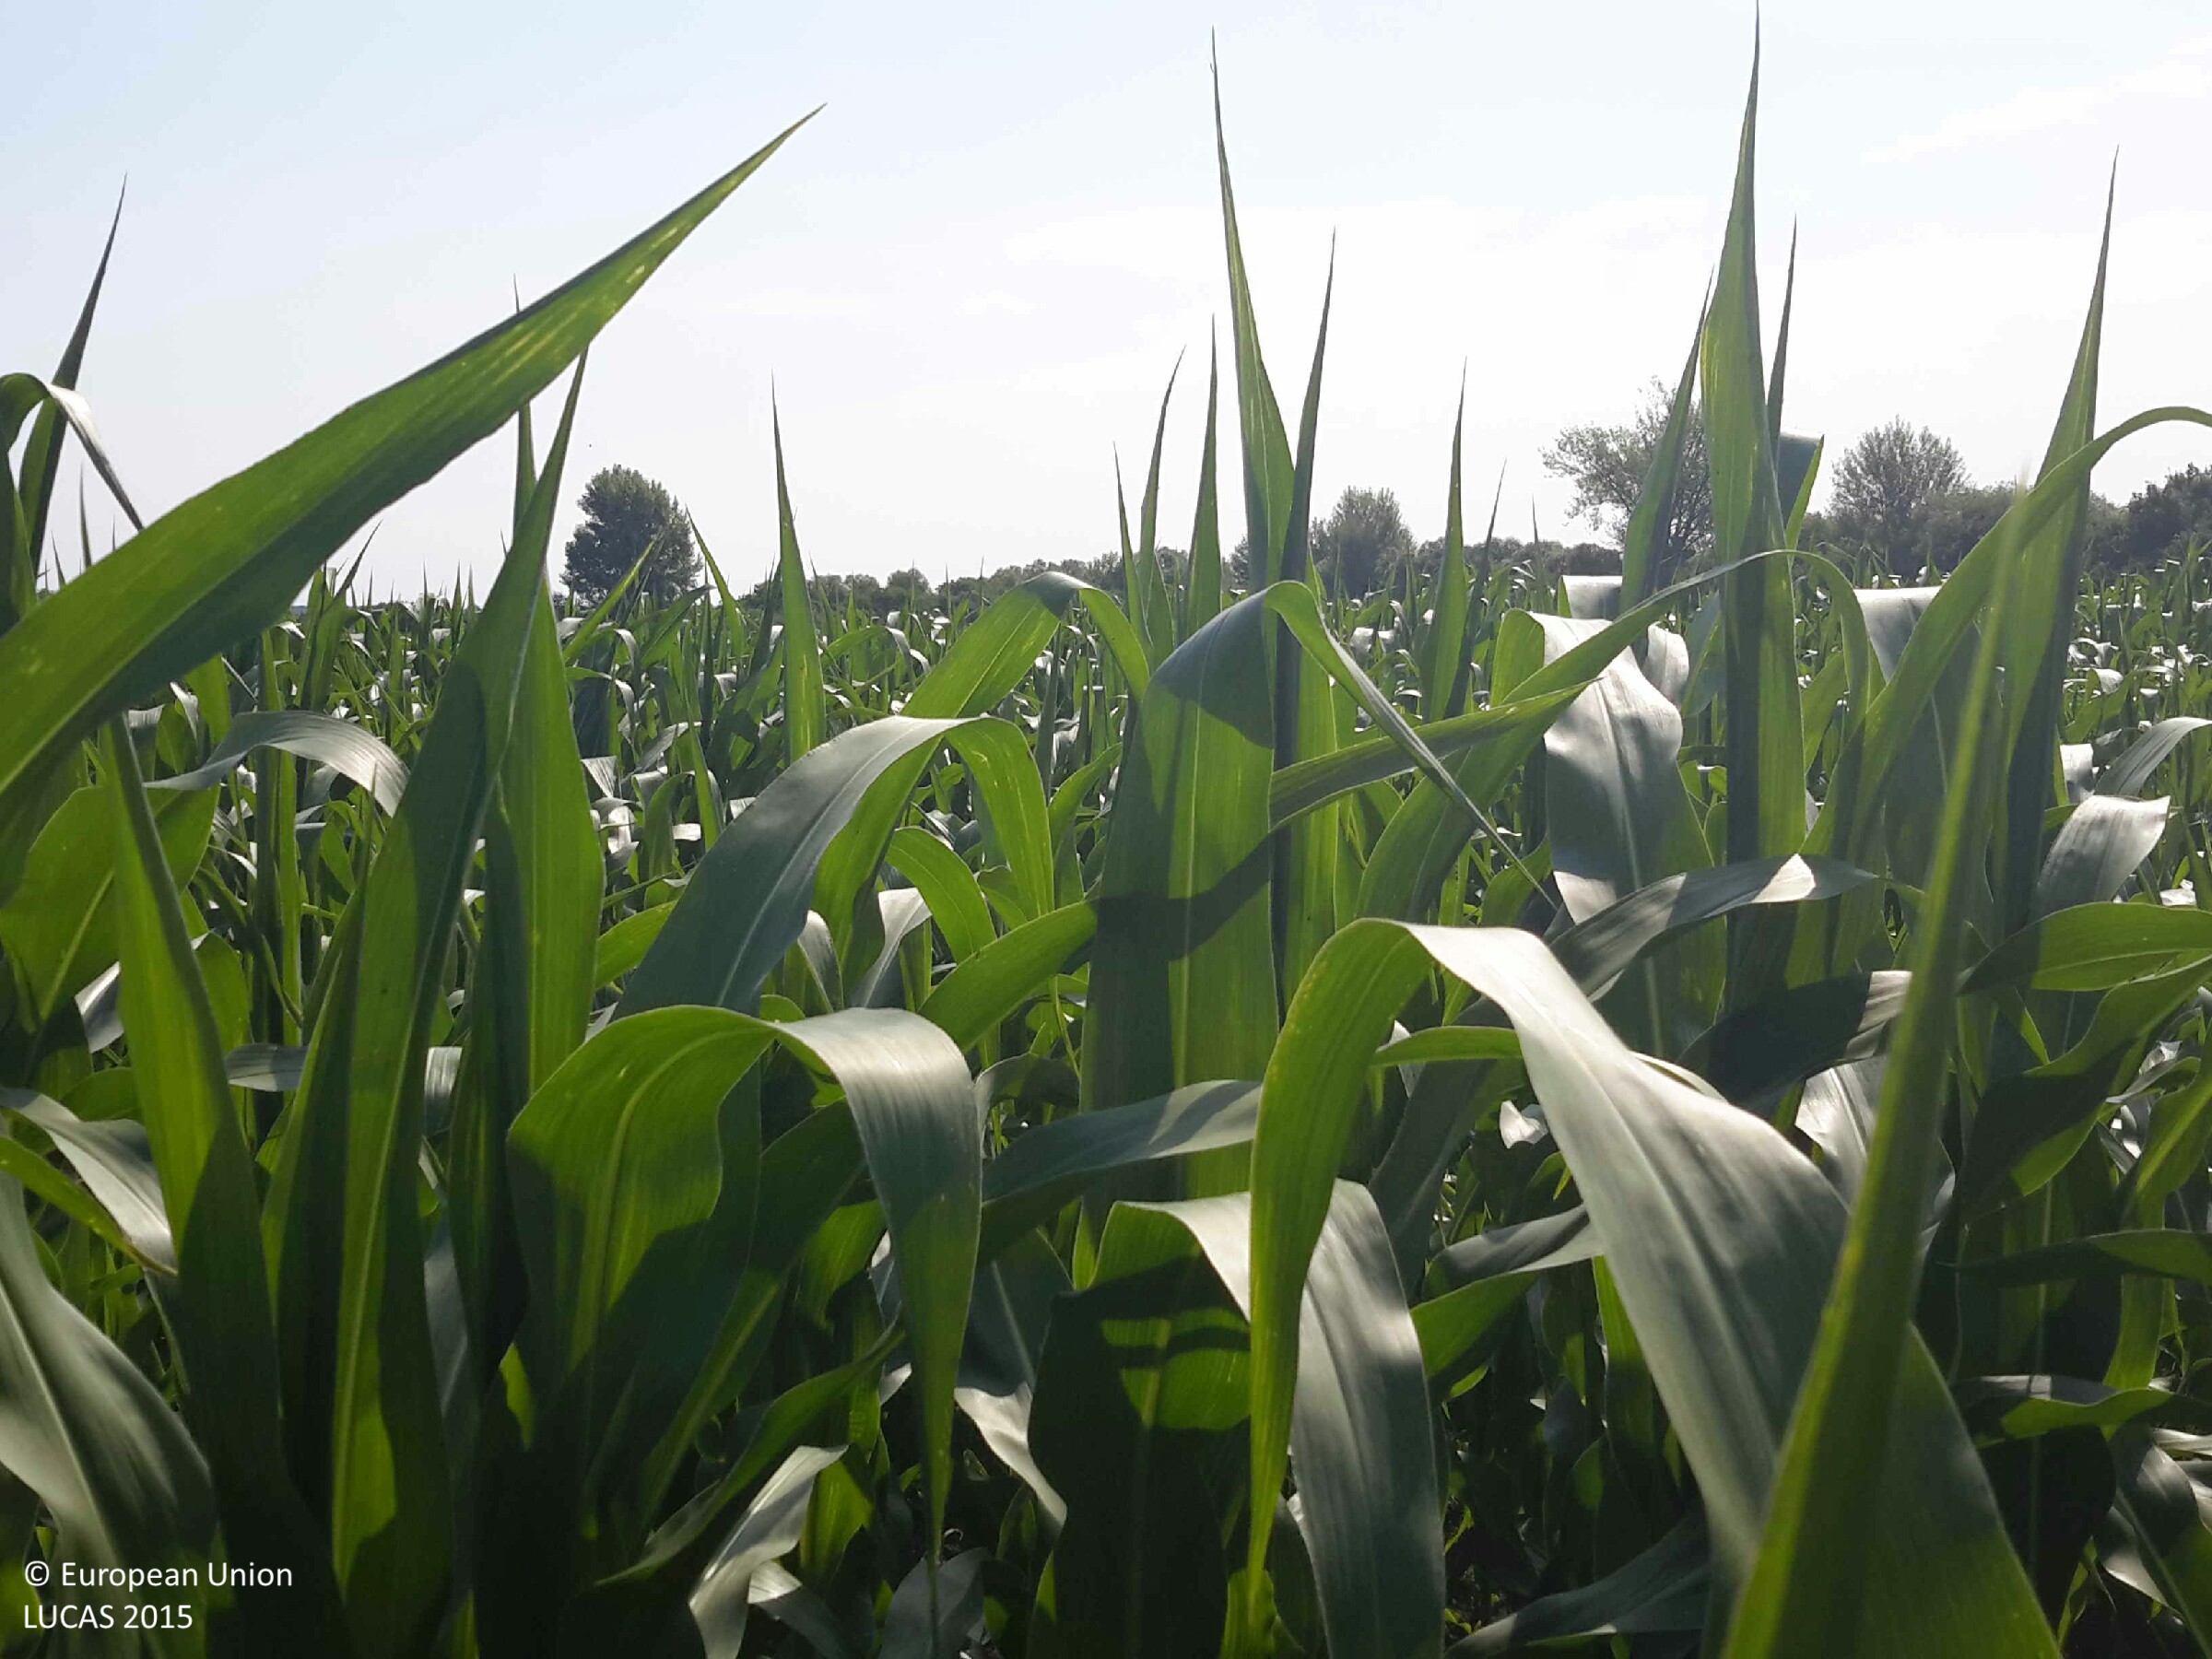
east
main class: Cropland
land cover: Maize
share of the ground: > 75 %
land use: Agriculture (excluding fallow land and kitchen gardens)
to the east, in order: Maize; Spontaneously vegetated surfaces; Shrubland with sparse tree cover
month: July
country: HU
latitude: 47.3703
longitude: 17.5164
